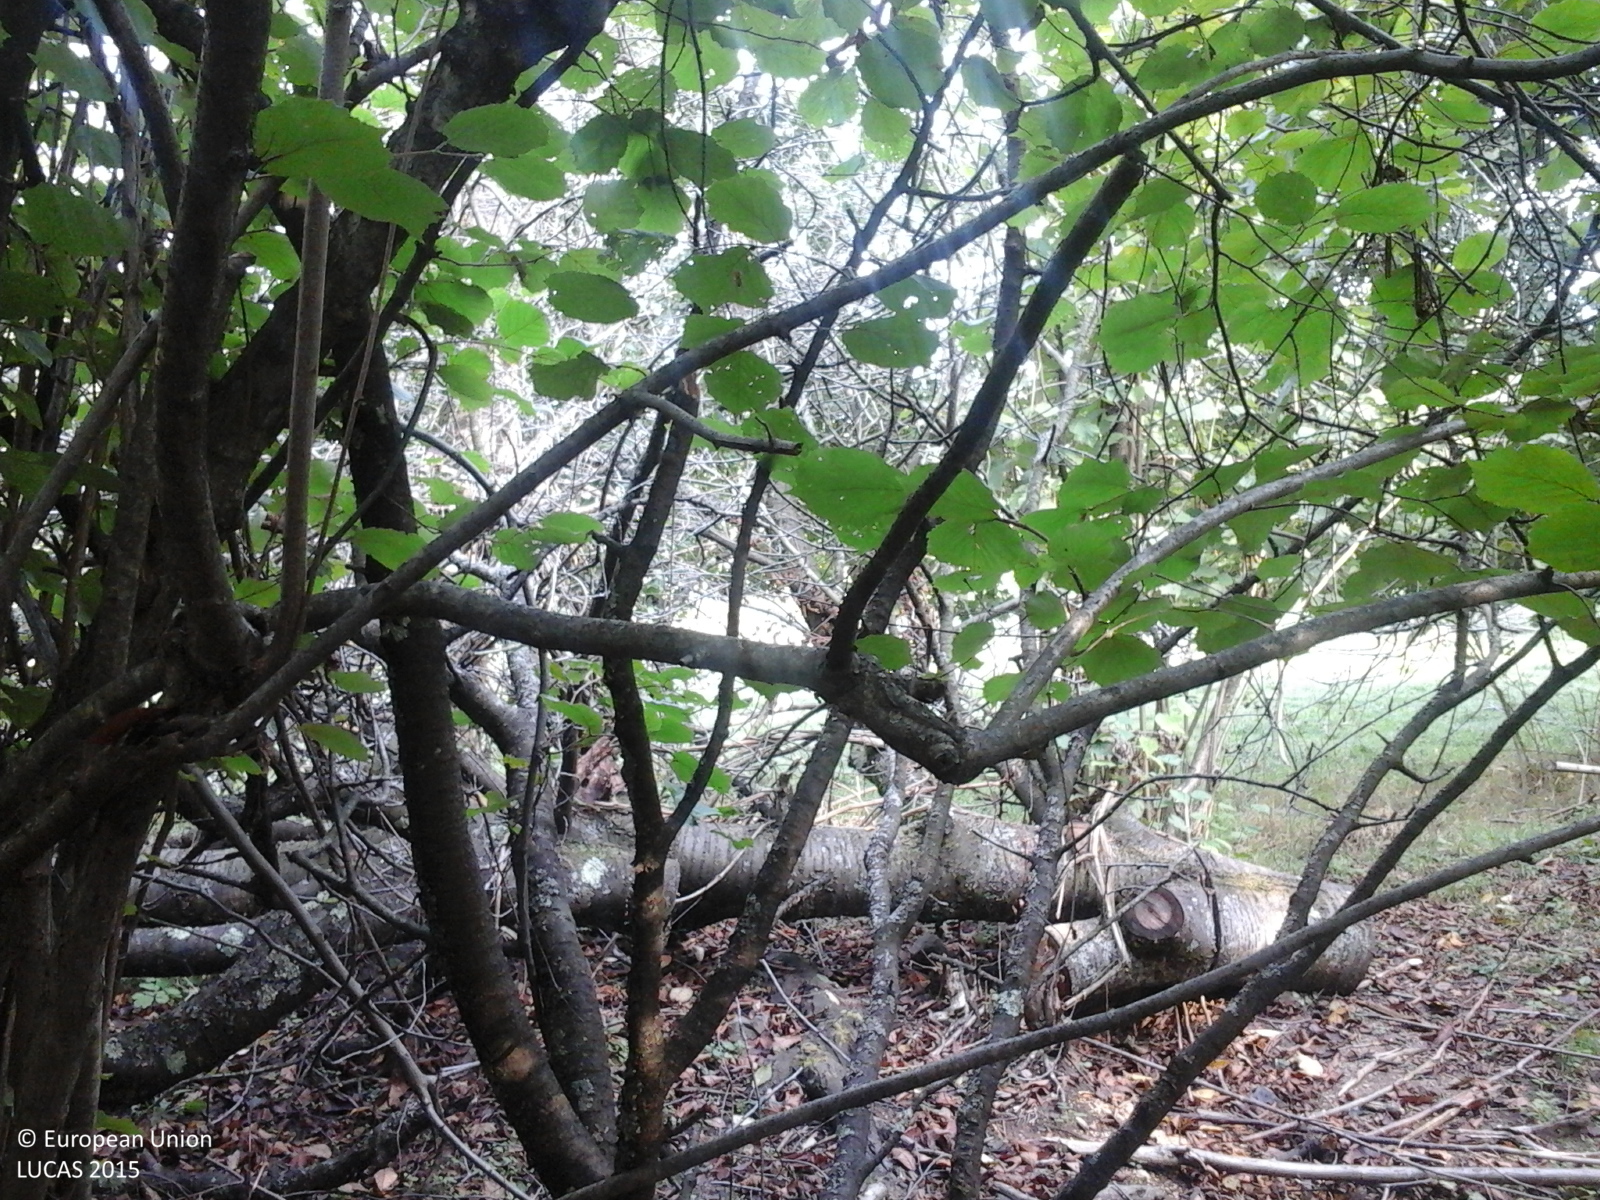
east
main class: Woodland
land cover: Broadleaved woodland
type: mesophytic deciduous forest
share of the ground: > 75 %
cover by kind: broadleaved forest trees 100 %
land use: Forestry
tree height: < 5 m
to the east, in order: Broadleaved woodland; Grassland without tree/shrub cover; Grassland with sparse tree/shrub cover; Other fruit trees and berries; Broadleaved woodland; Fences; Broadleaved woodland; Grassland without tree/shrub cover; Other fruit trees and berries
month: September
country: RO
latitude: 45.5322
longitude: 22.4269
